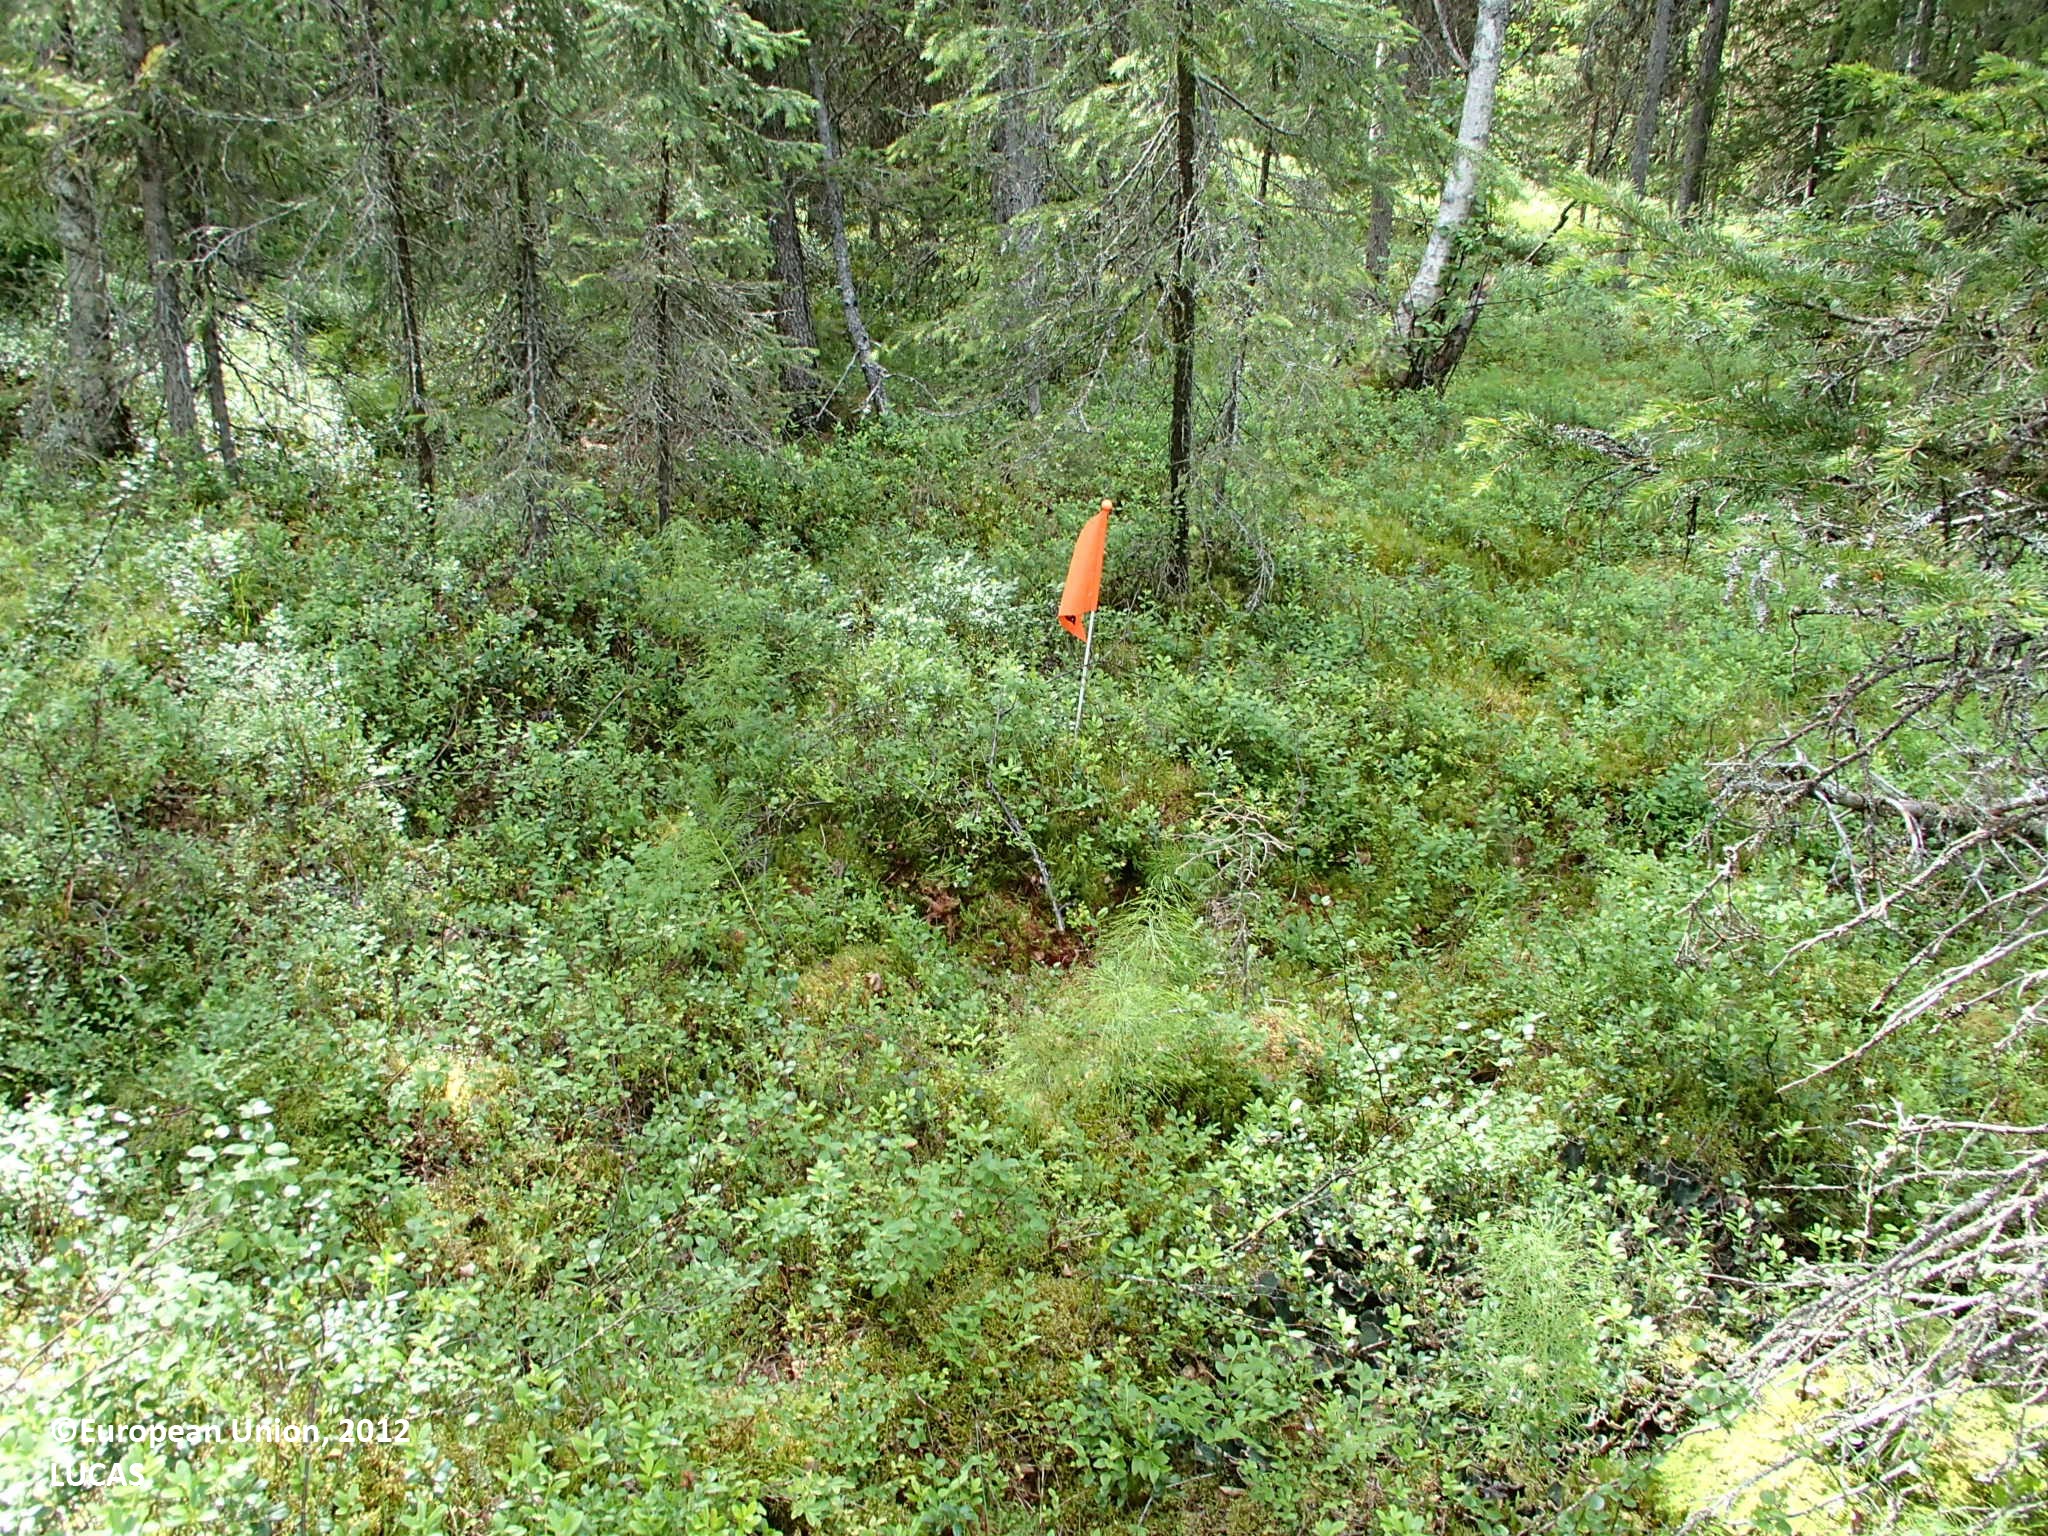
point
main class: Woodland
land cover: Spruce dominated mixed woodland
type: boreal forest
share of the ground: > 75 %
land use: Forestry
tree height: > 5 m
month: July
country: FI
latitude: 66.6984
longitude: 25.3496
